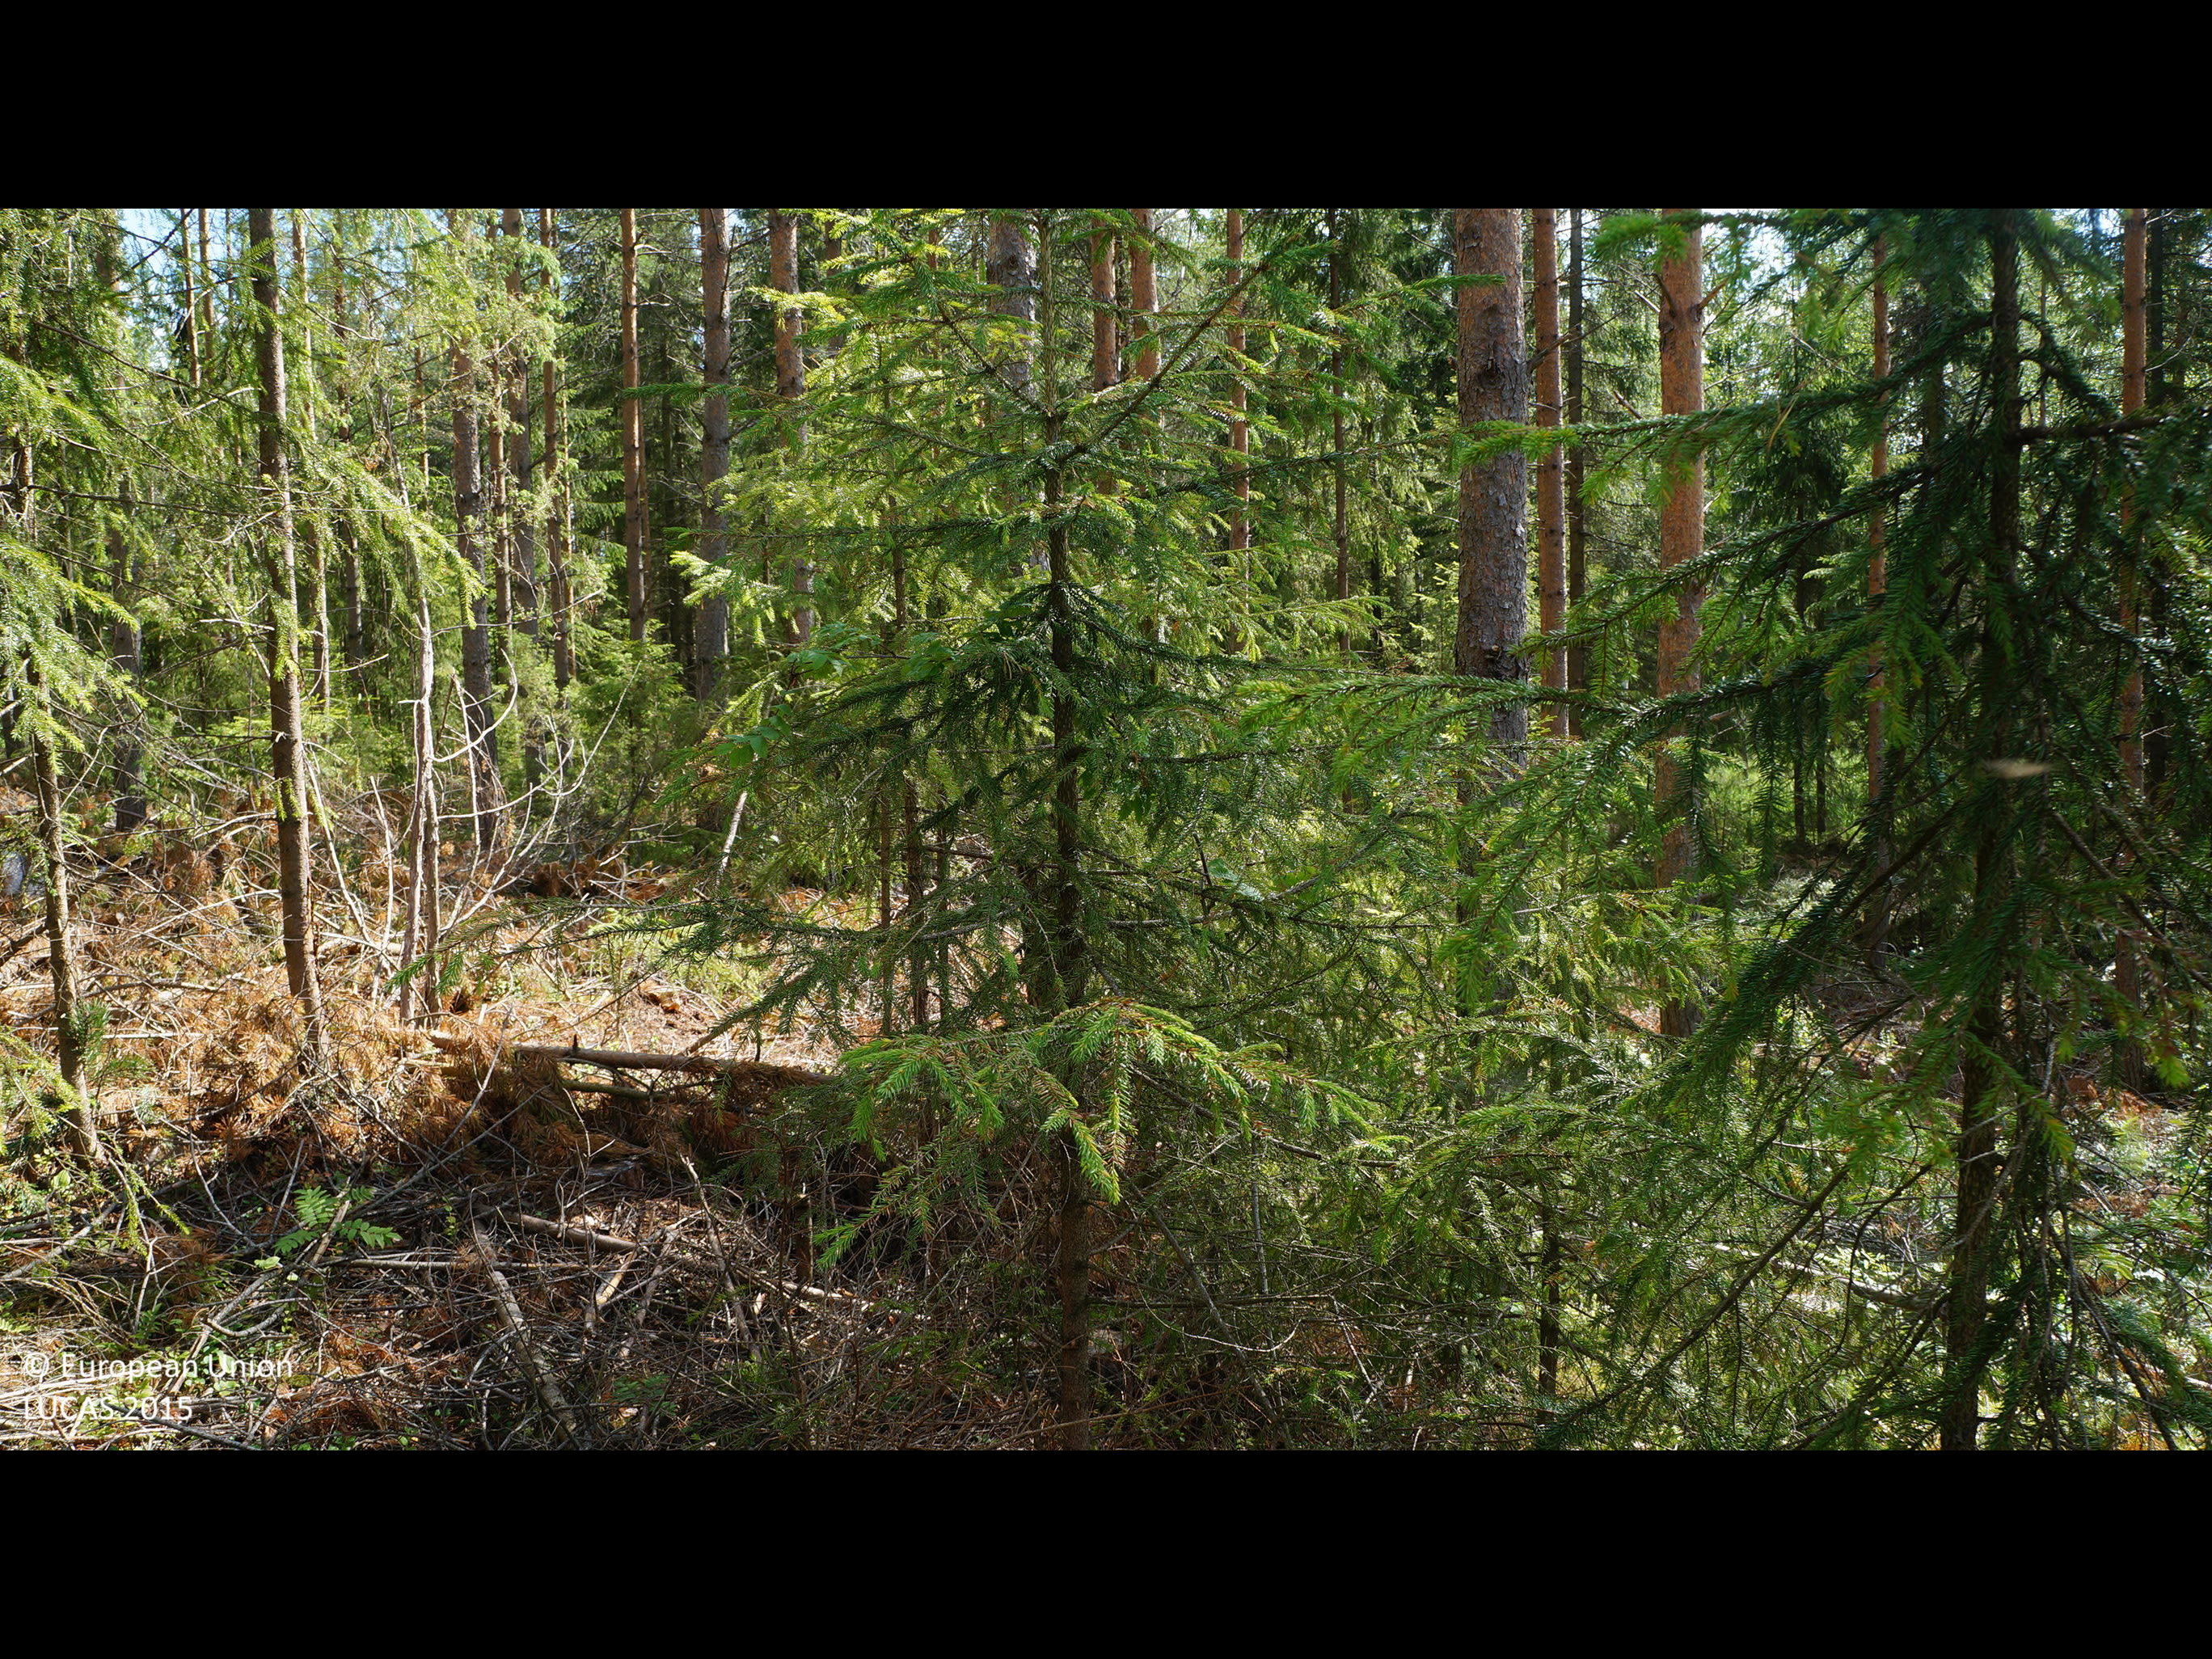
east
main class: Woodland
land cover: Other coniferous woodland
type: boreal forest
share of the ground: 50 - 75 %
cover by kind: coniferous forest trees 55 %, shrubs 30 %, lichens and mosses 10 %
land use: Forestry
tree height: > 5 m
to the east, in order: Other coniferous woodland; Pine dominated mixed woodland; Tracks; Pine dominated coniferous woodland; Spruce dominated mixed woodland
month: July
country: FI
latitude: 63.9241
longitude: 24.3667
